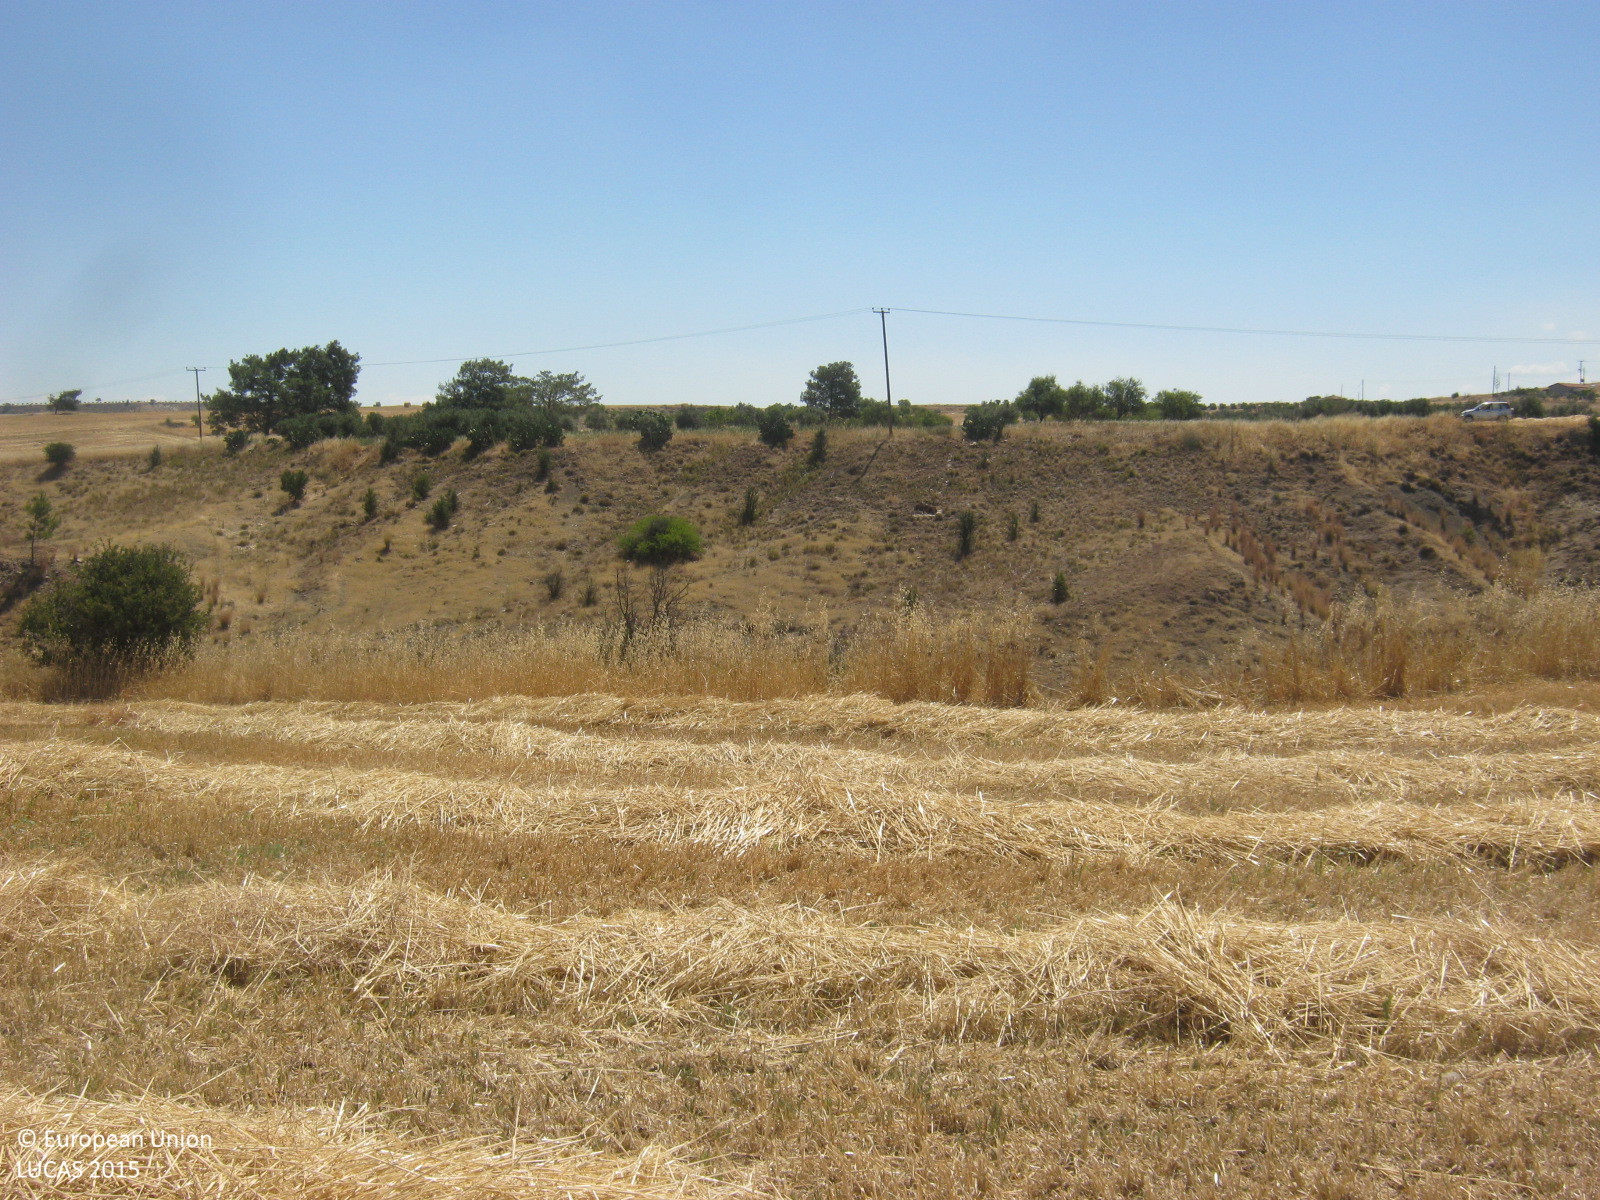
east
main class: Cropland
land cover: Barley
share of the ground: < 10 %
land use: Agriculture (excluding fallow land and kitchen gardens)
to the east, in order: Barley; Grassland with sparse tree/shrub cover; Rivers and streams; Grassland with sparse tree/shrub cover; Electric lines; Other bare soil; Tracks; Nuts trees; Grassland without tree/shrub cover; Other bare soil
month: June
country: CY
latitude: 35.0271
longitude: 33.1880
